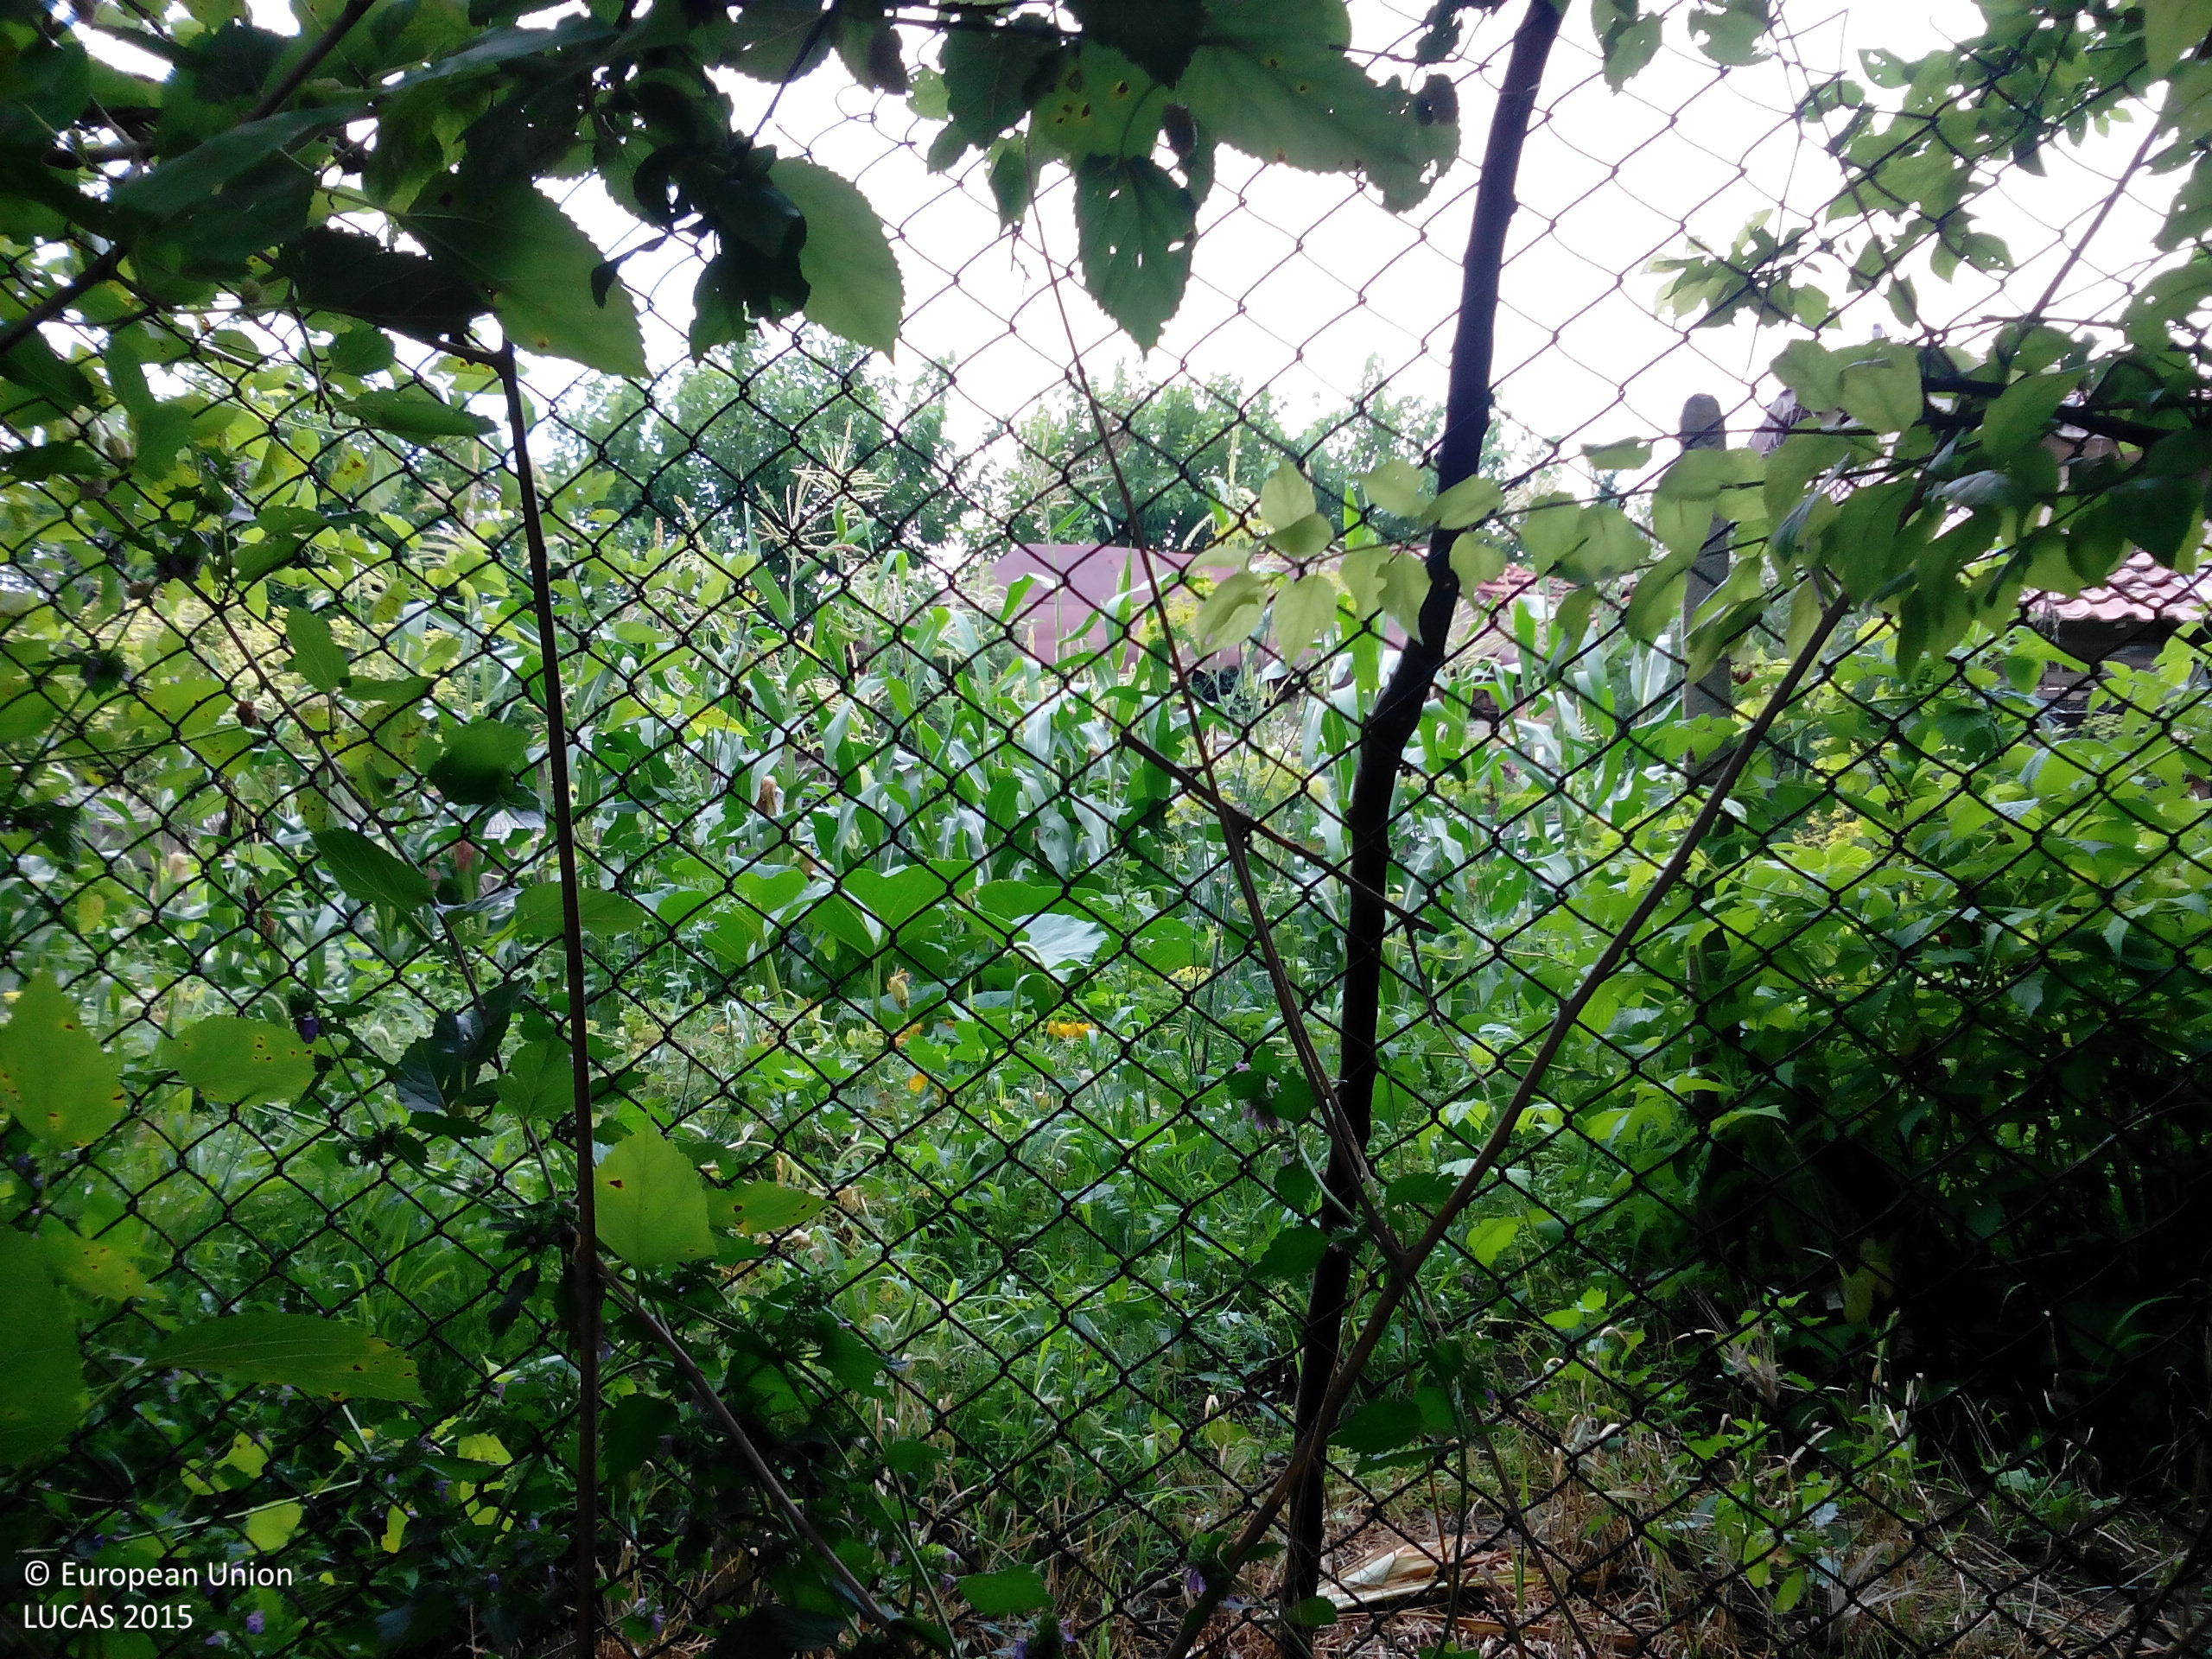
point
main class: Cropland
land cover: Maize
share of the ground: > 75 %
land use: Kitchen garden
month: July
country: BG
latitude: 43.4335
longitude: 24.1254
